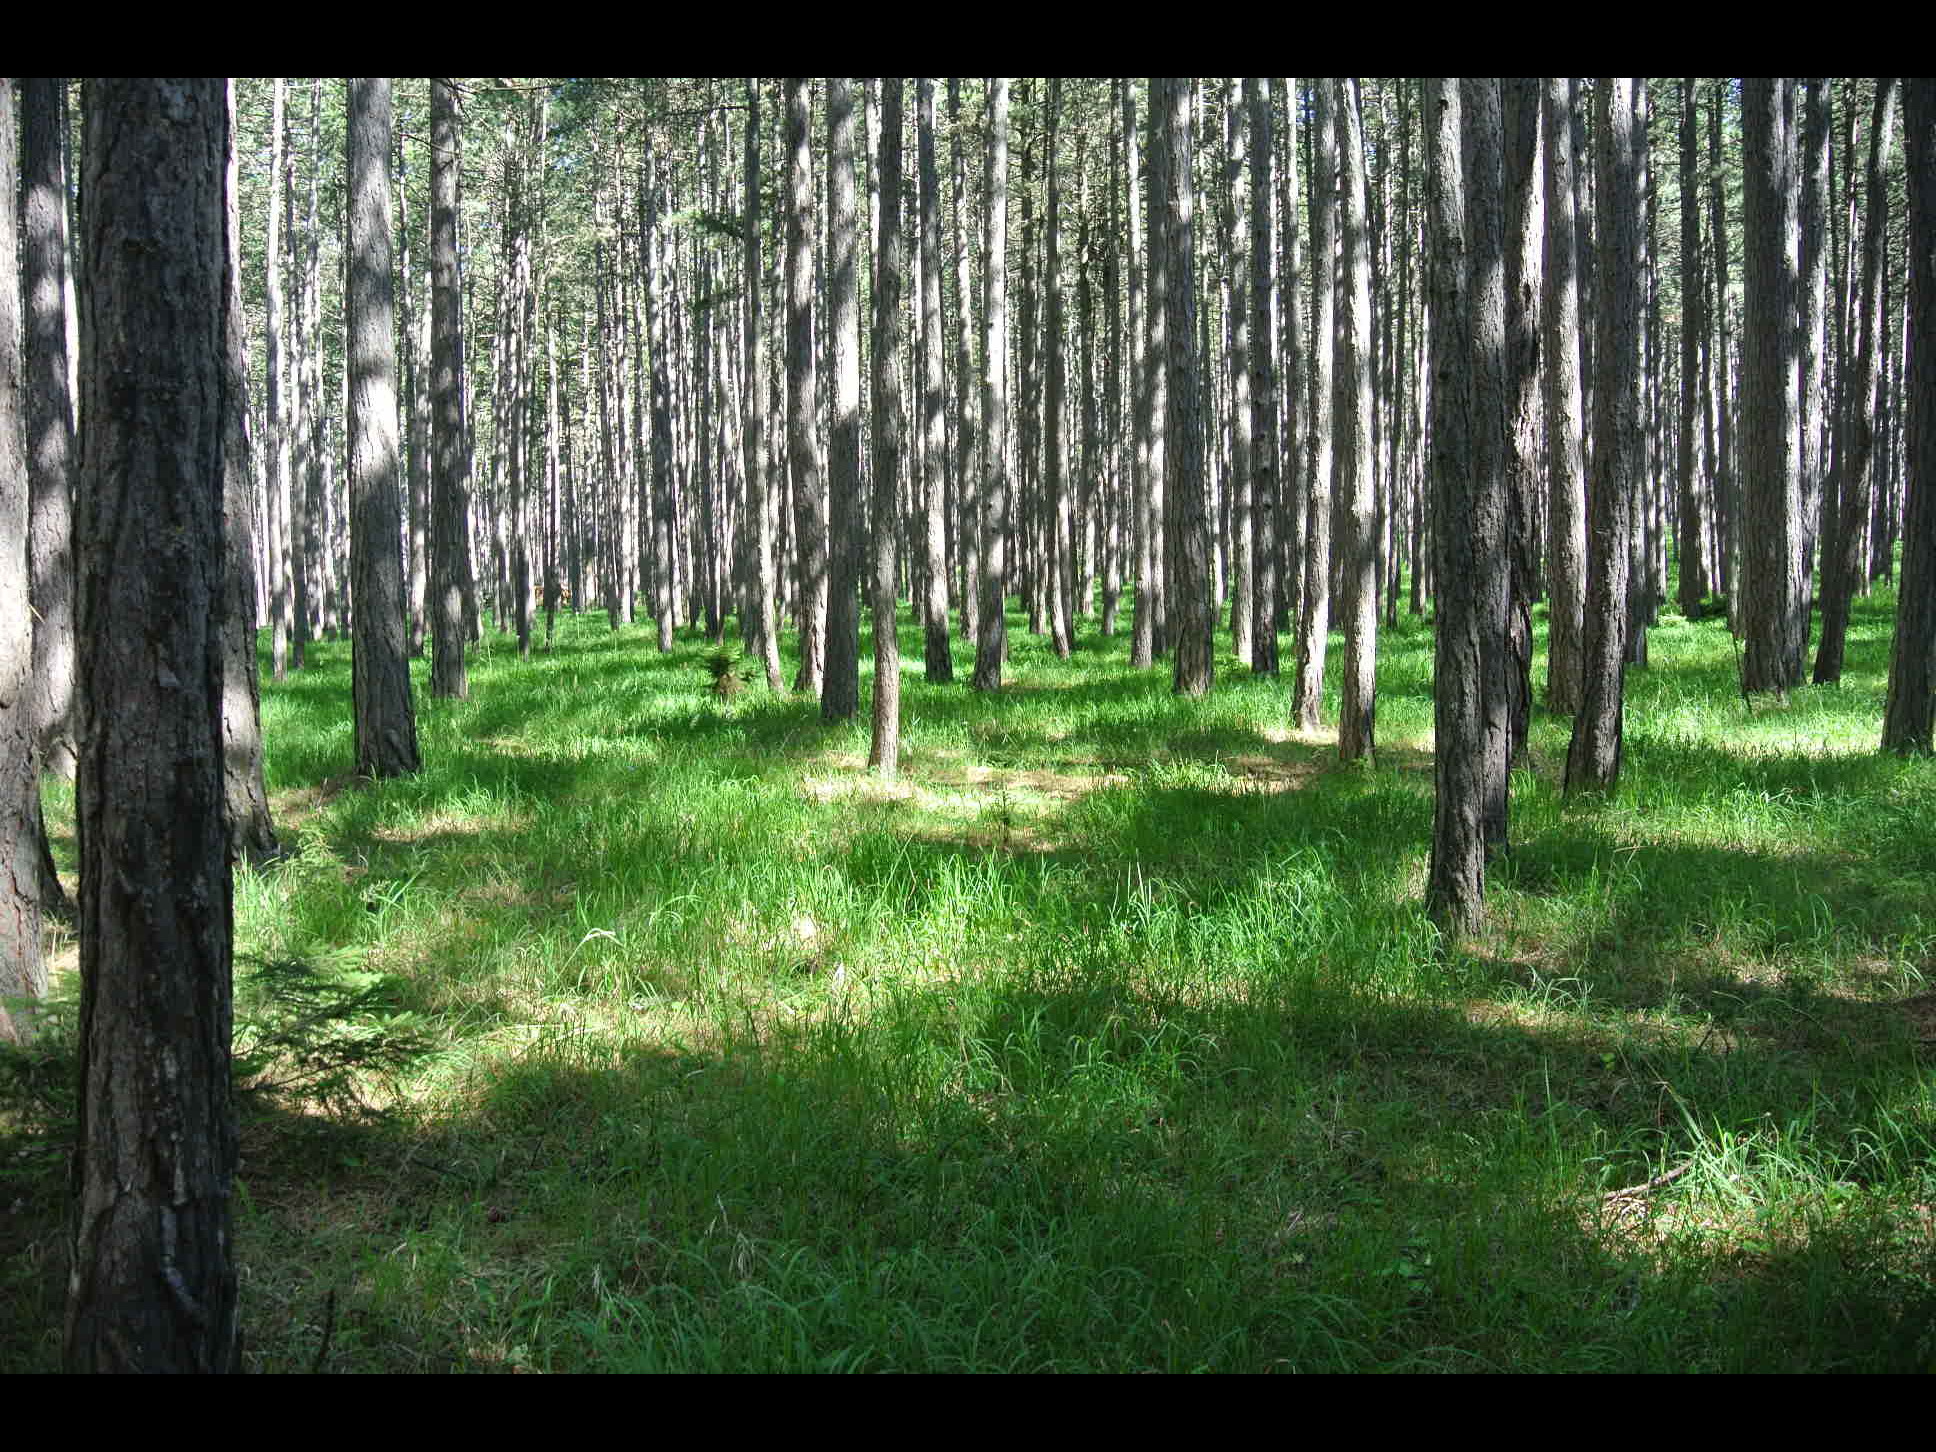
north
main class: Woodland
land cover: Pine dominated coniferous woodland
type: alpine coniferous forest
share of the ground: > 75 %
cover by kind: coniferous forest trees 100 %
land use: Forestry
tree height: > 5 m
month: July
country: AT
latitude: 47.7494
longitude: 16.0719
